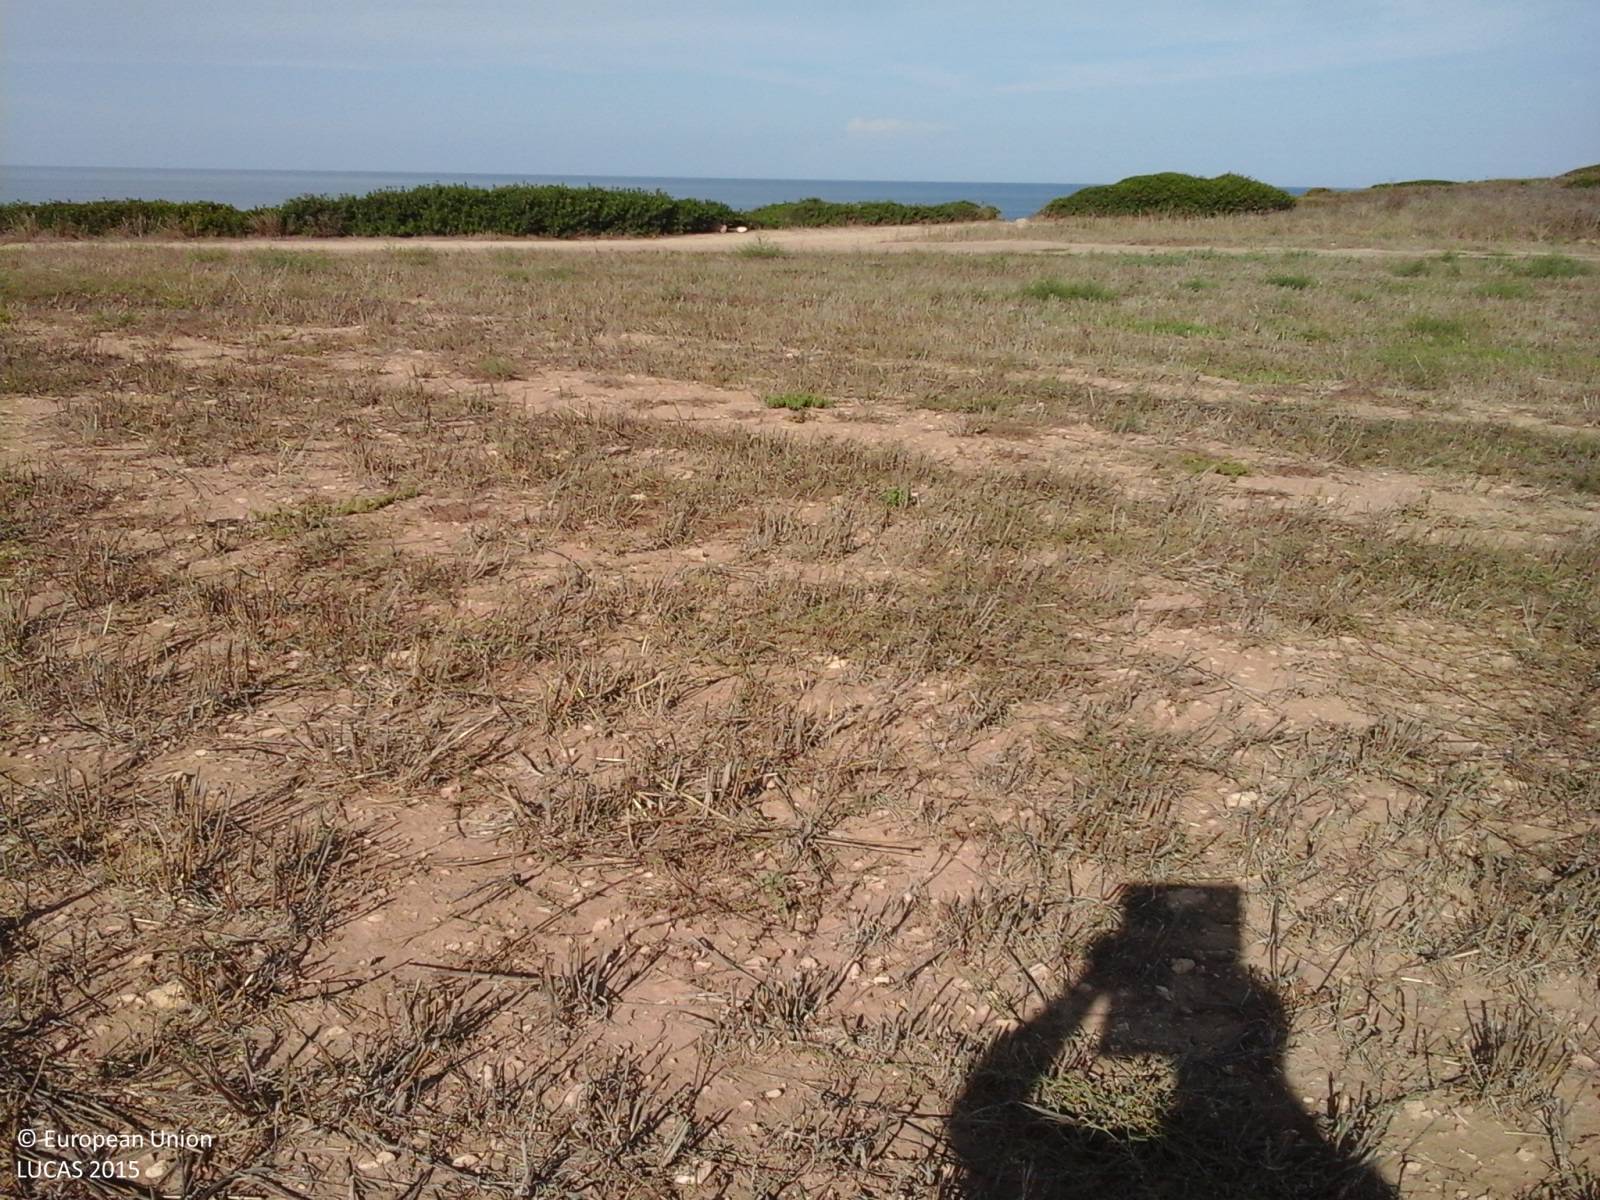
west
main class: Cropland
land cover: Mixed cereals for fodder
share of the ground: 10 - 25 %
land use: Agriculture (excluding fallow land and kitchen gardens)
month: September
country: IT
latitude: 40.0367
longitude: 8.3797
